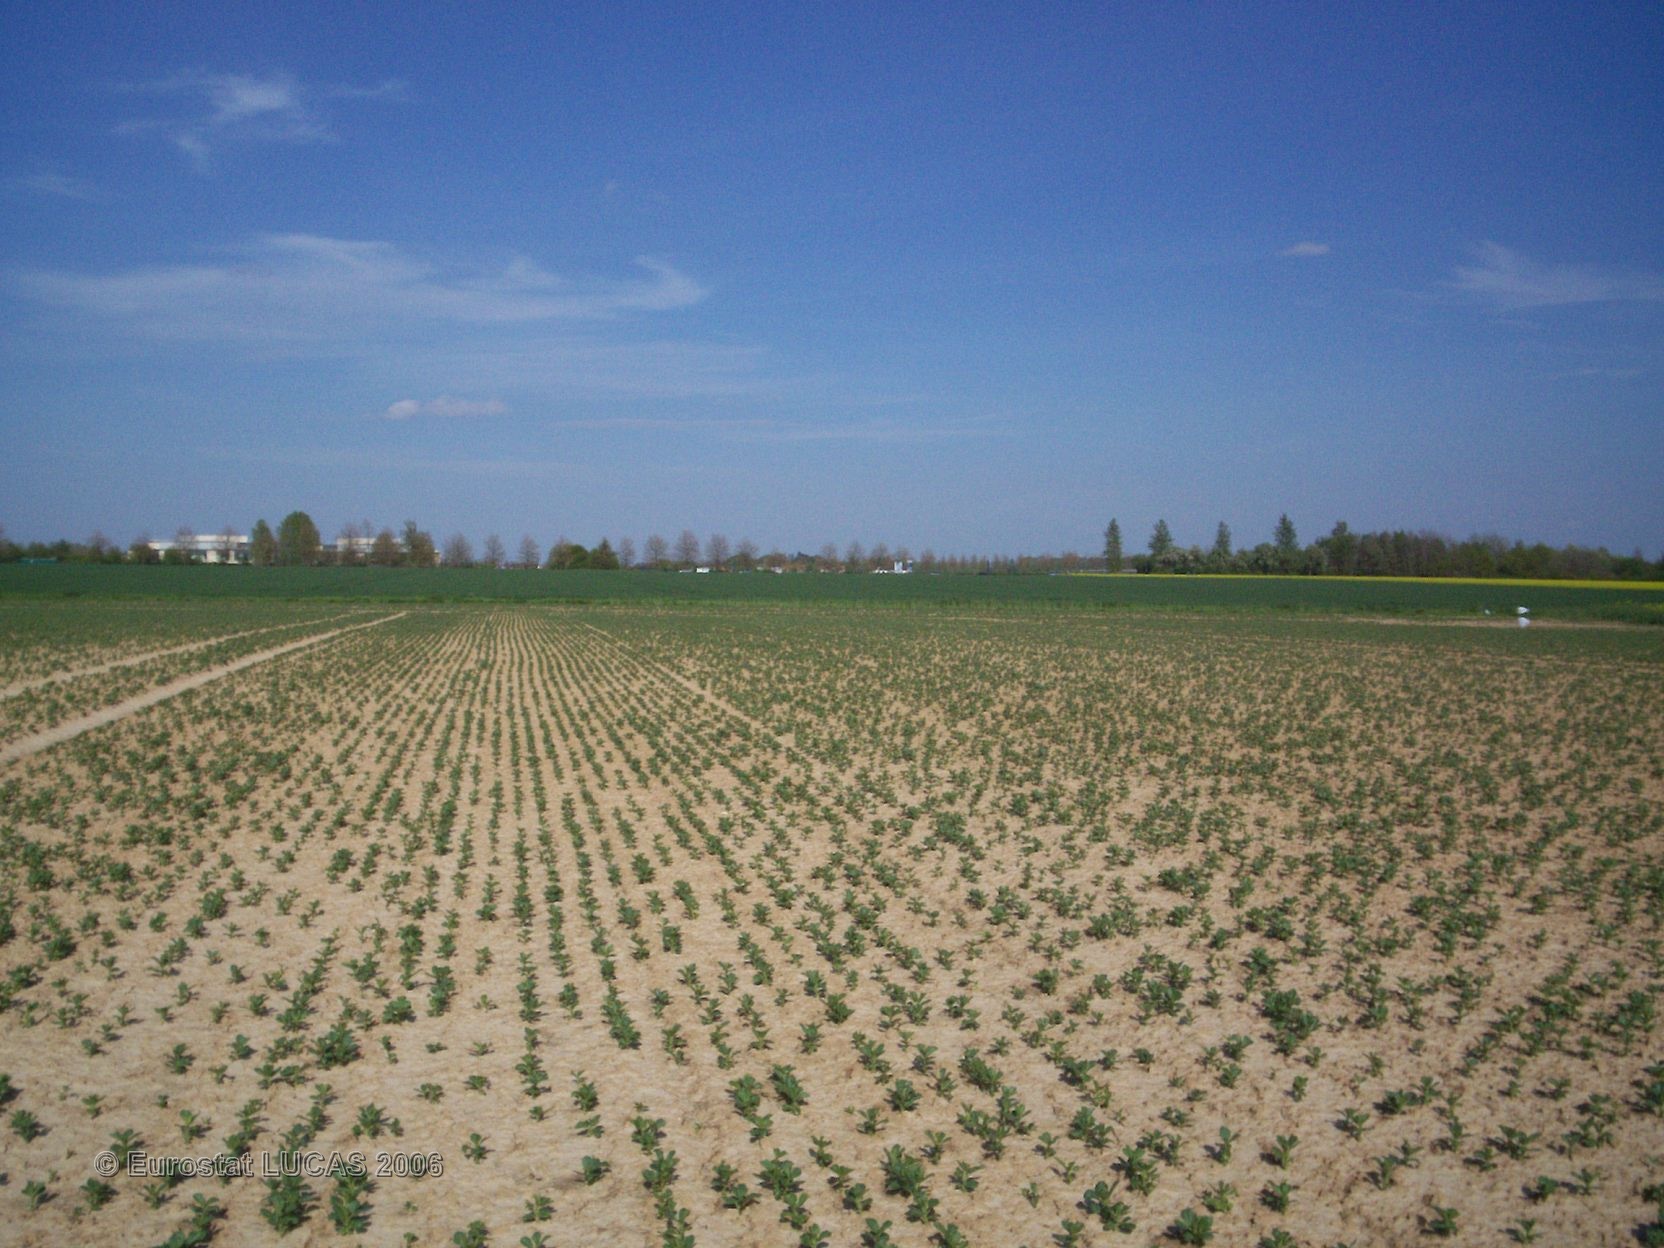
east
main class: Cropland
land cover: Sugar beet
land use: Agriculture (excluding fallow land and kitchen gardens)
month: May
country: FR
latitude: 48.8359
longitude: 2.7832
